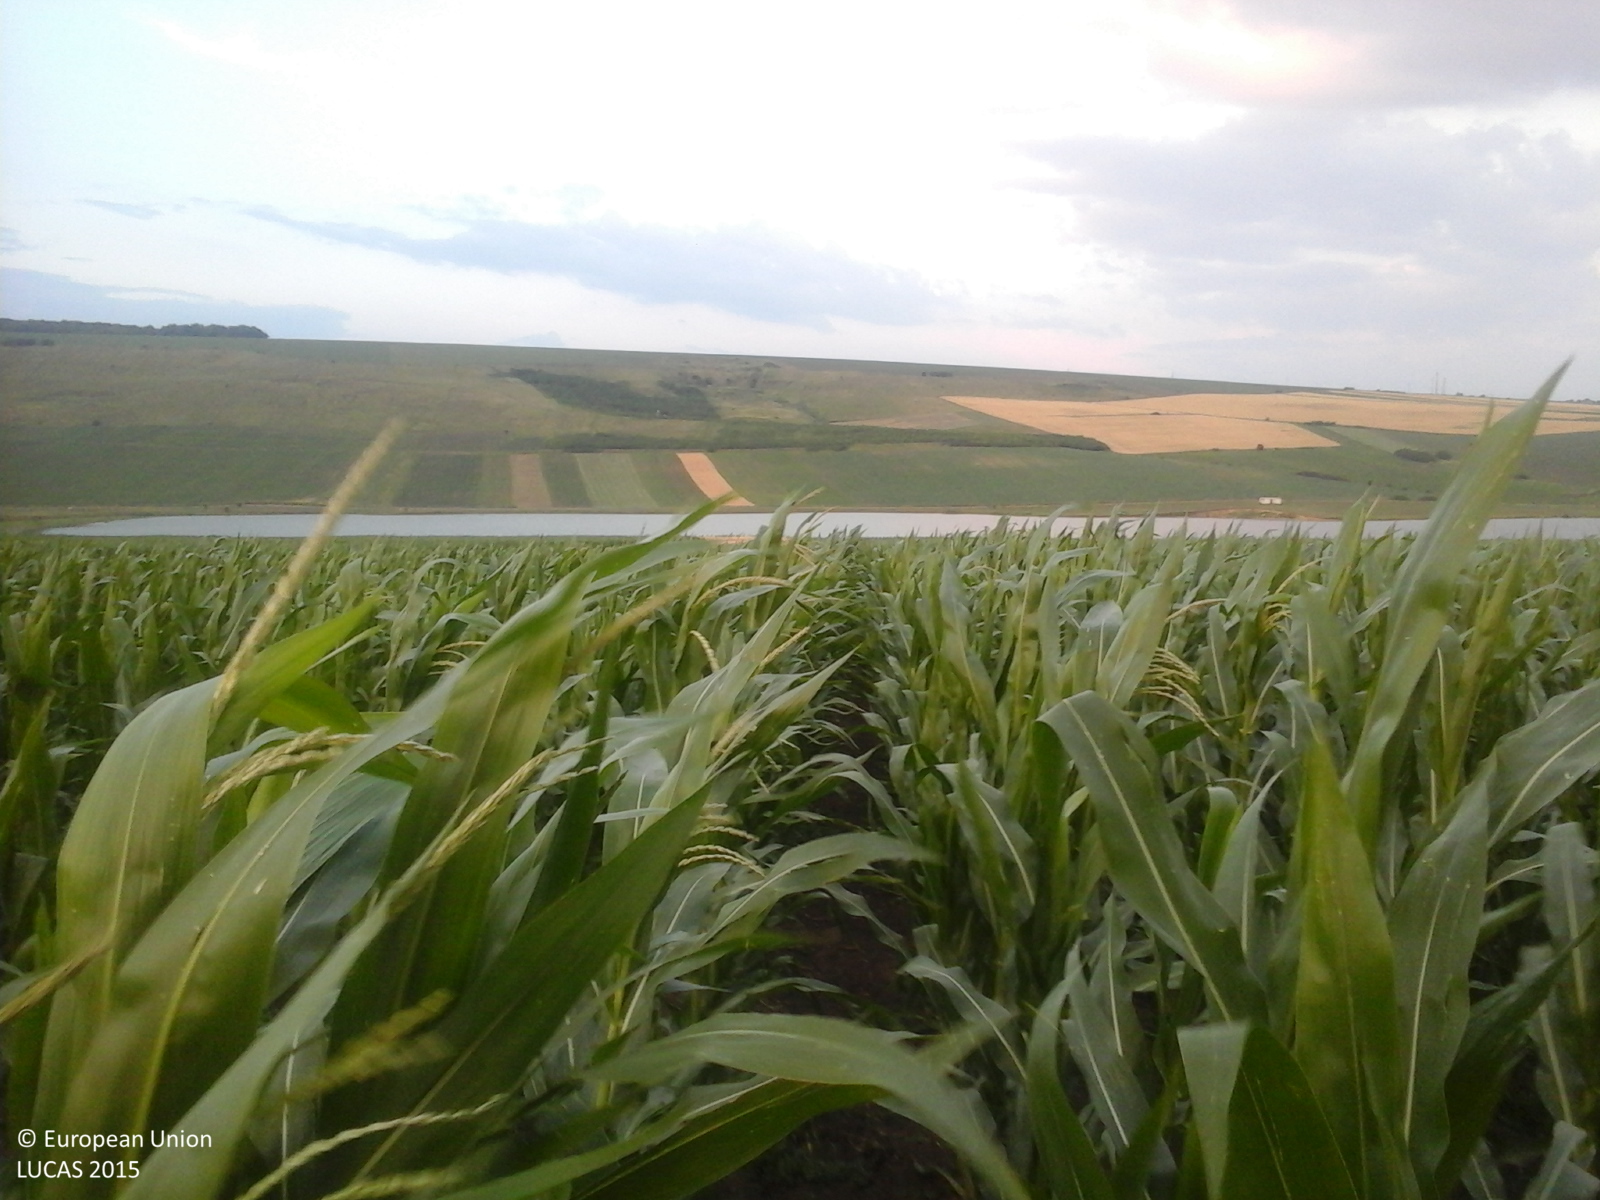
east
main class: Cropland
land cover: Maize
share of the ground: > 75 %
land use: Agriculture (excluding fallow land and kitchen gardens)
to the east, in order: Maize
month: June
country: RO
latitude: 46.8560
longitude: 27.4378
